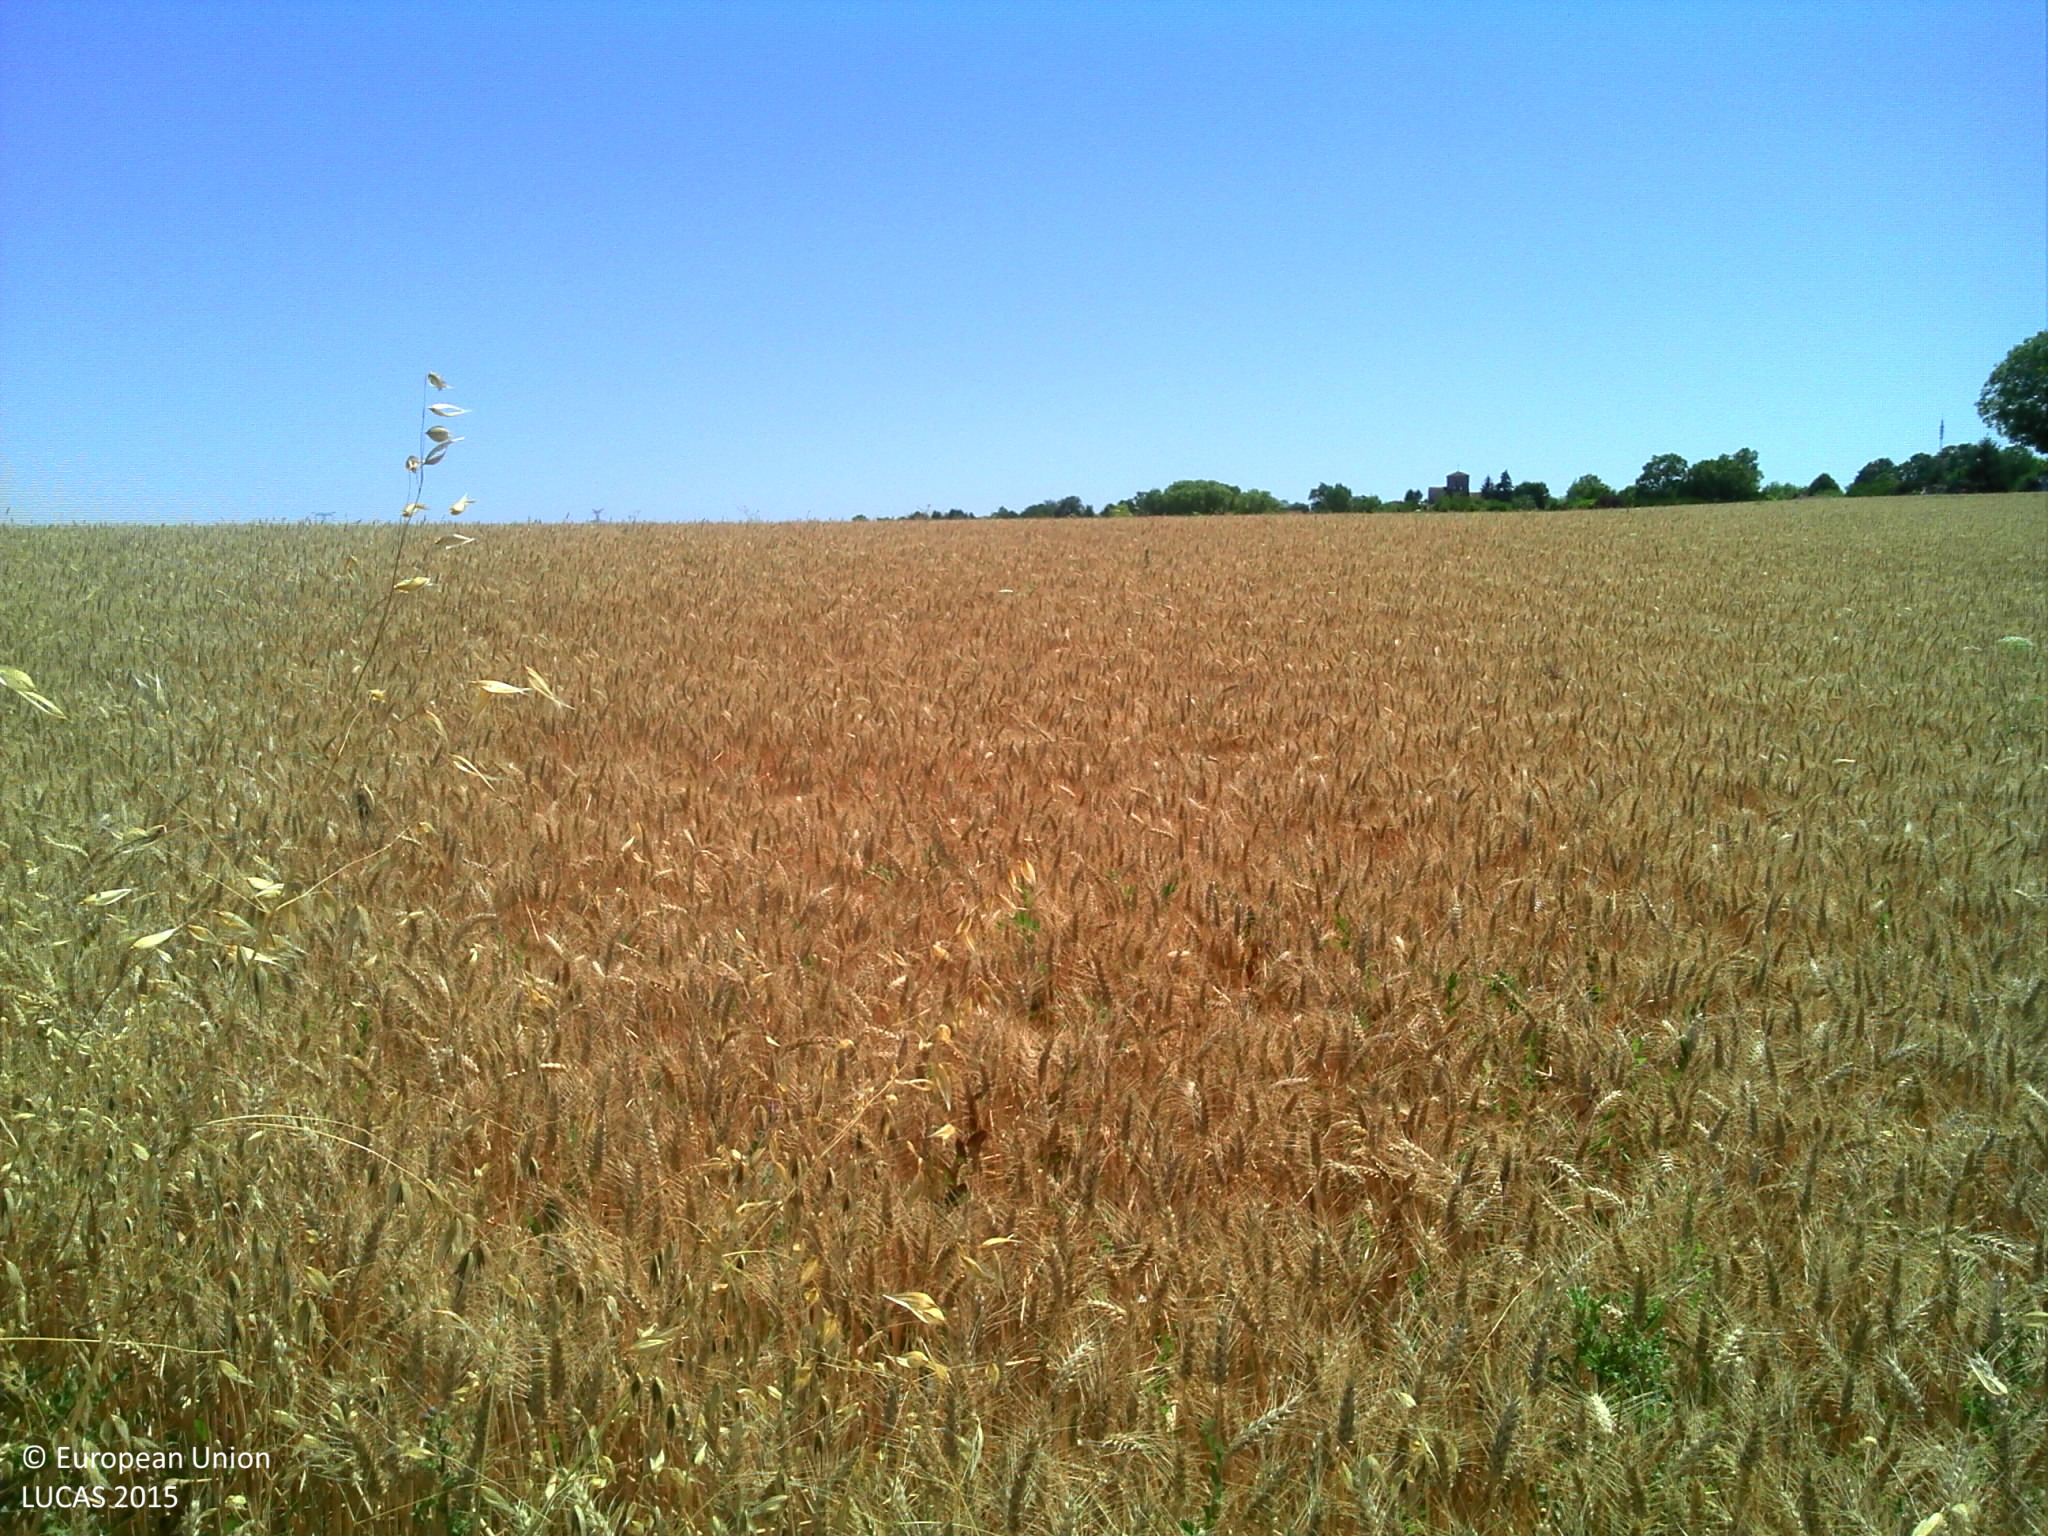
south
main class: Cropland
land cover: Common wheat
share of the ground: > 75 %
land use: Agriculture (excluding fallow land and kitchen gardens)
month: June
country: FR
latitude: 45.6762
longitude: -0.6147
